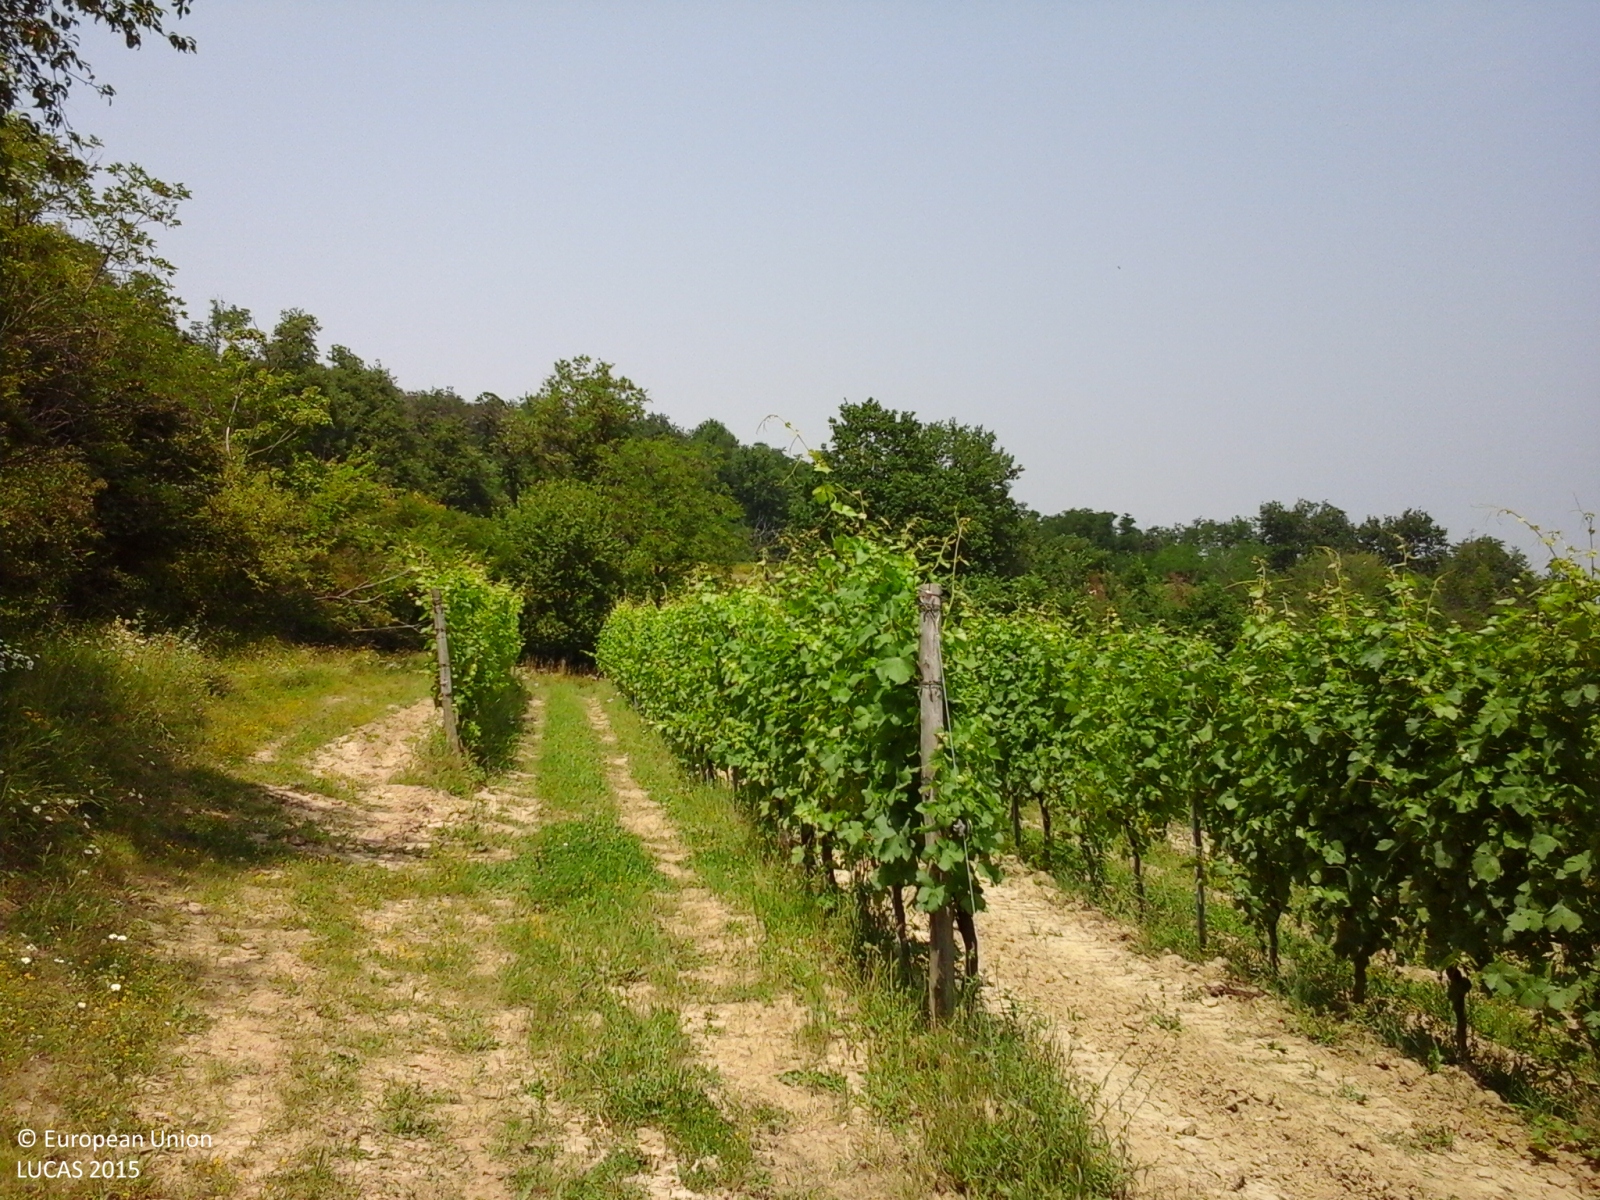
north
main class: Woodland
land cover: Broadleaved woodland
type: thermophilous deciduous forest
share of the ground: > 75 %
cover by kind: broadleaved forest trees 100 %
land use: Forestry
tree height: > 5 m
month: July
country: IT
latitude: 44.7044
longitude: 8.8035
